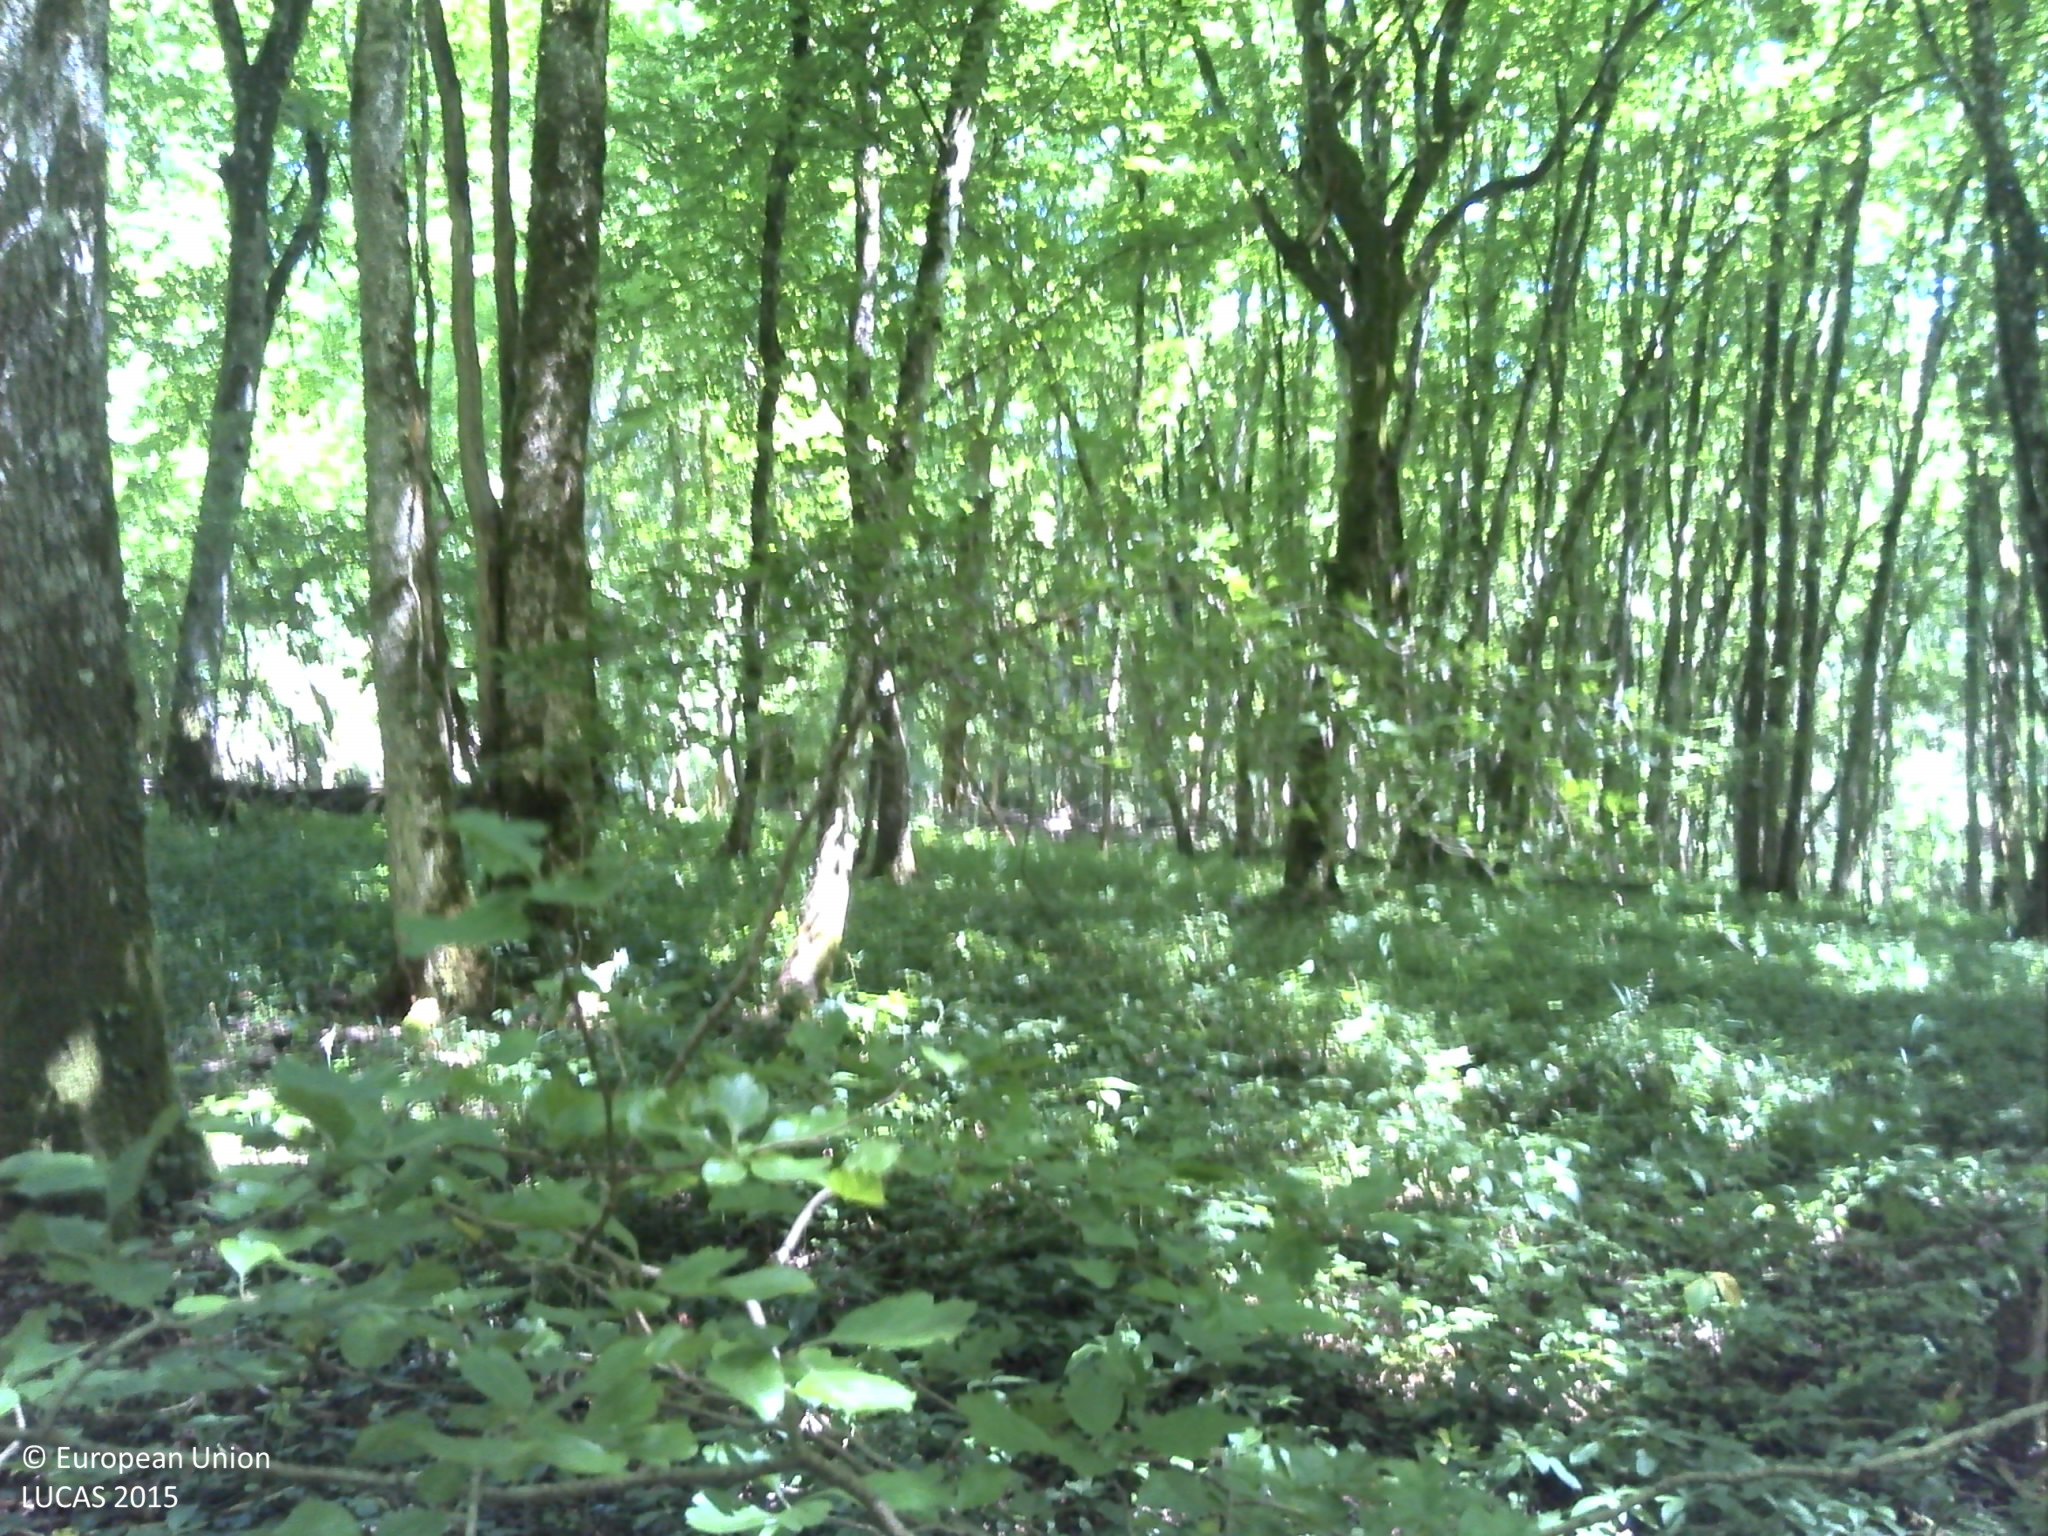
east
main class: Woodland
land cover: Broadleaved woodland
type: mesophytic deciduous forest
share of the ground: > 75 %
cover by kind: broadleaved forest trees 100 %
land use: Forestry
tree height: > 5 m
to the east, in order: Broadleaved woodland; Grass margins; Ditches and canals; Grass margins; Paved roads, cycling and walking lanes; Grassland without tree/shrub cover; Ditches and canals; Broadleaved woodland; Tracks; Broadleaved woodland
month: June
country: FR
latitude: 49.3765
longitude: 6.0189
